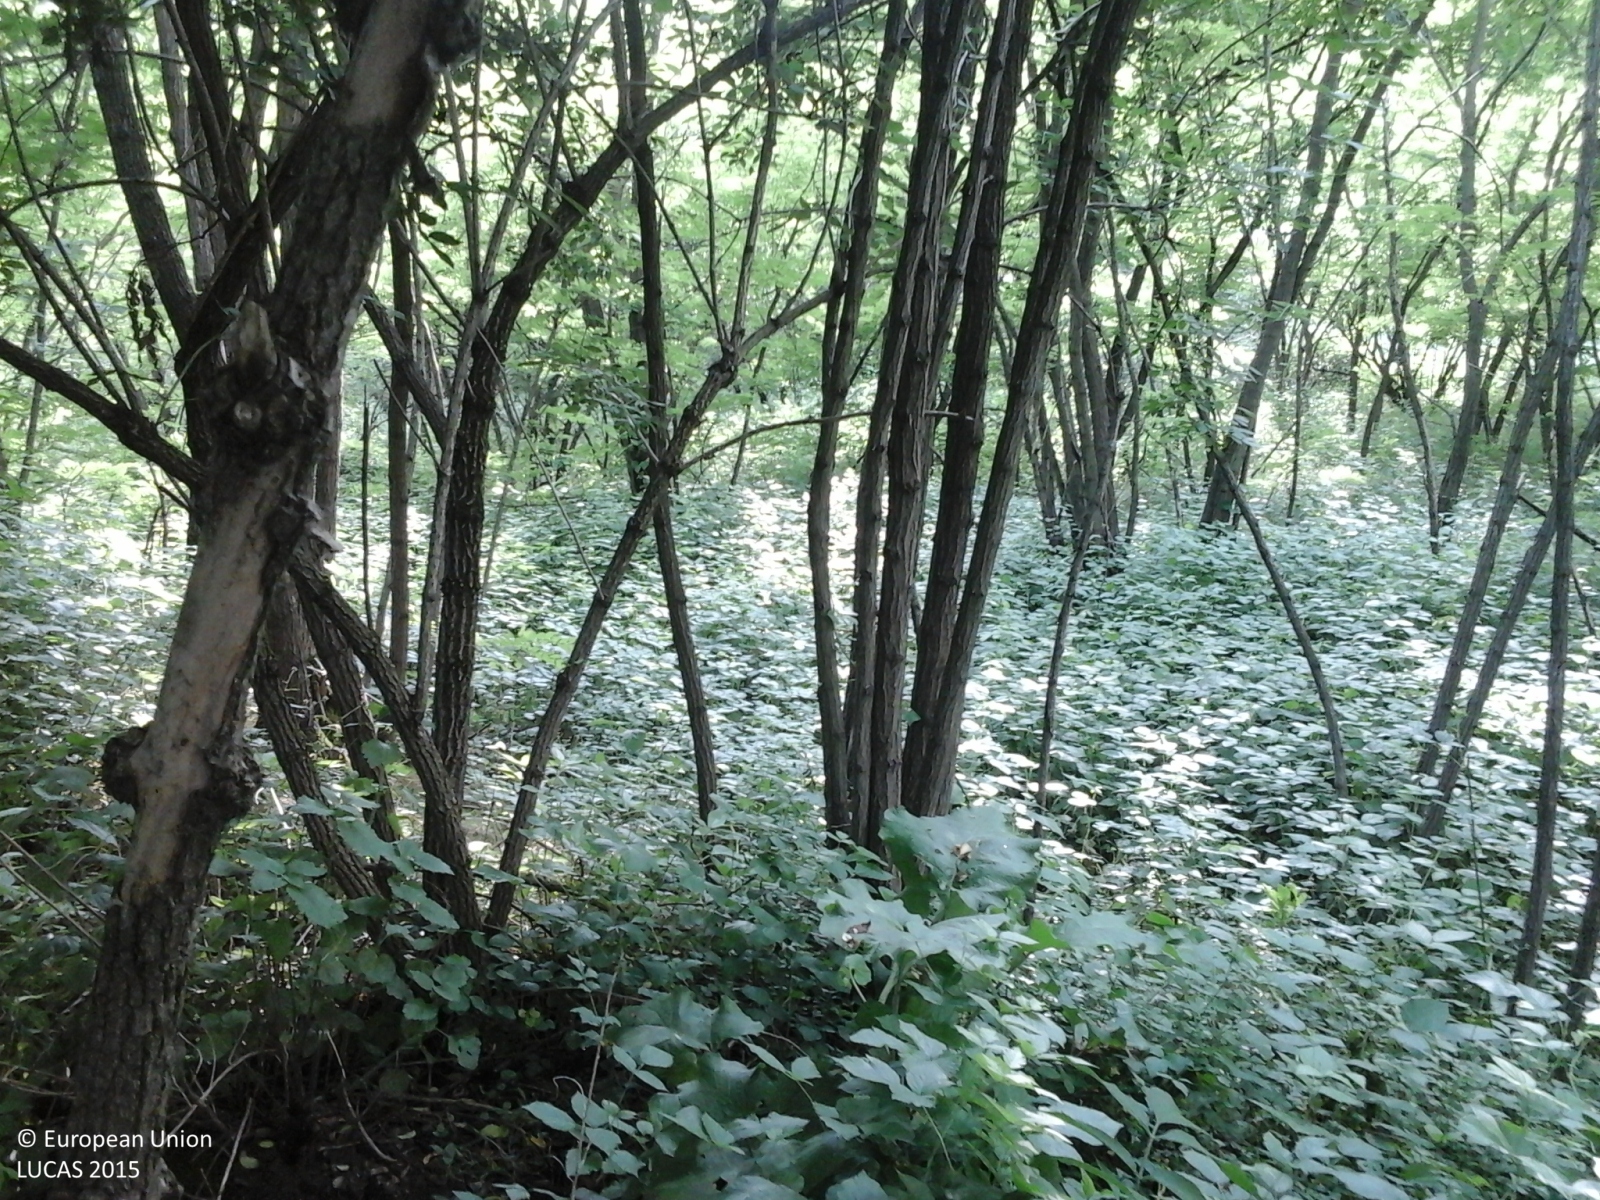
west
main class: Woodland
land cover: Broadleaved woodland
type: thermophilous deciduous forest
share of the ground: > 75 %
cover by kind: broadleaved forest trees 100 %
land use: Forestry
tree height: > 5 m
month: June
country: IT
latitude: 45.3792
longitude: 8.1004
